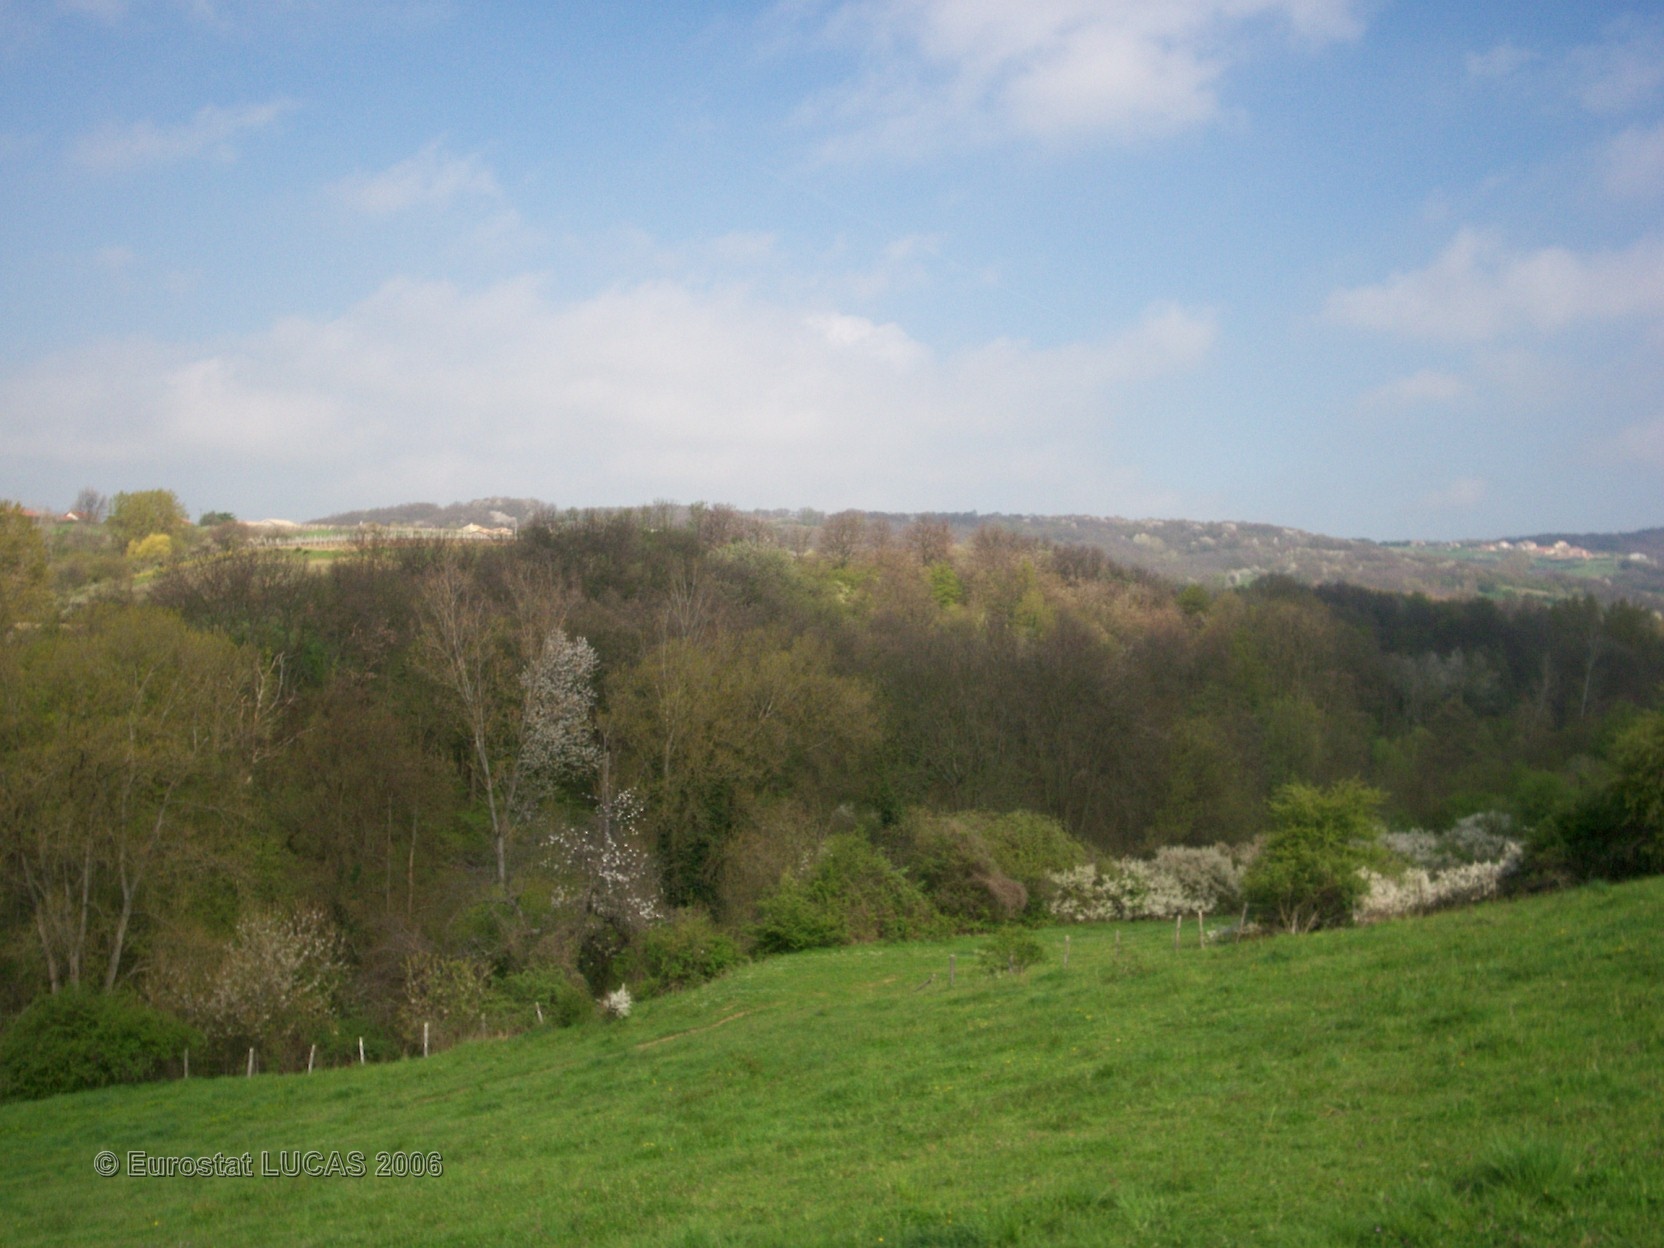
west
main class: Grassland
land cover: Grassland with sparse tree/shrub cover
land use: Agriculture (excluding fallow land and kitchen gardens)
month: April
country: FR
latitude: 45.5025
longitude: 4.7953
